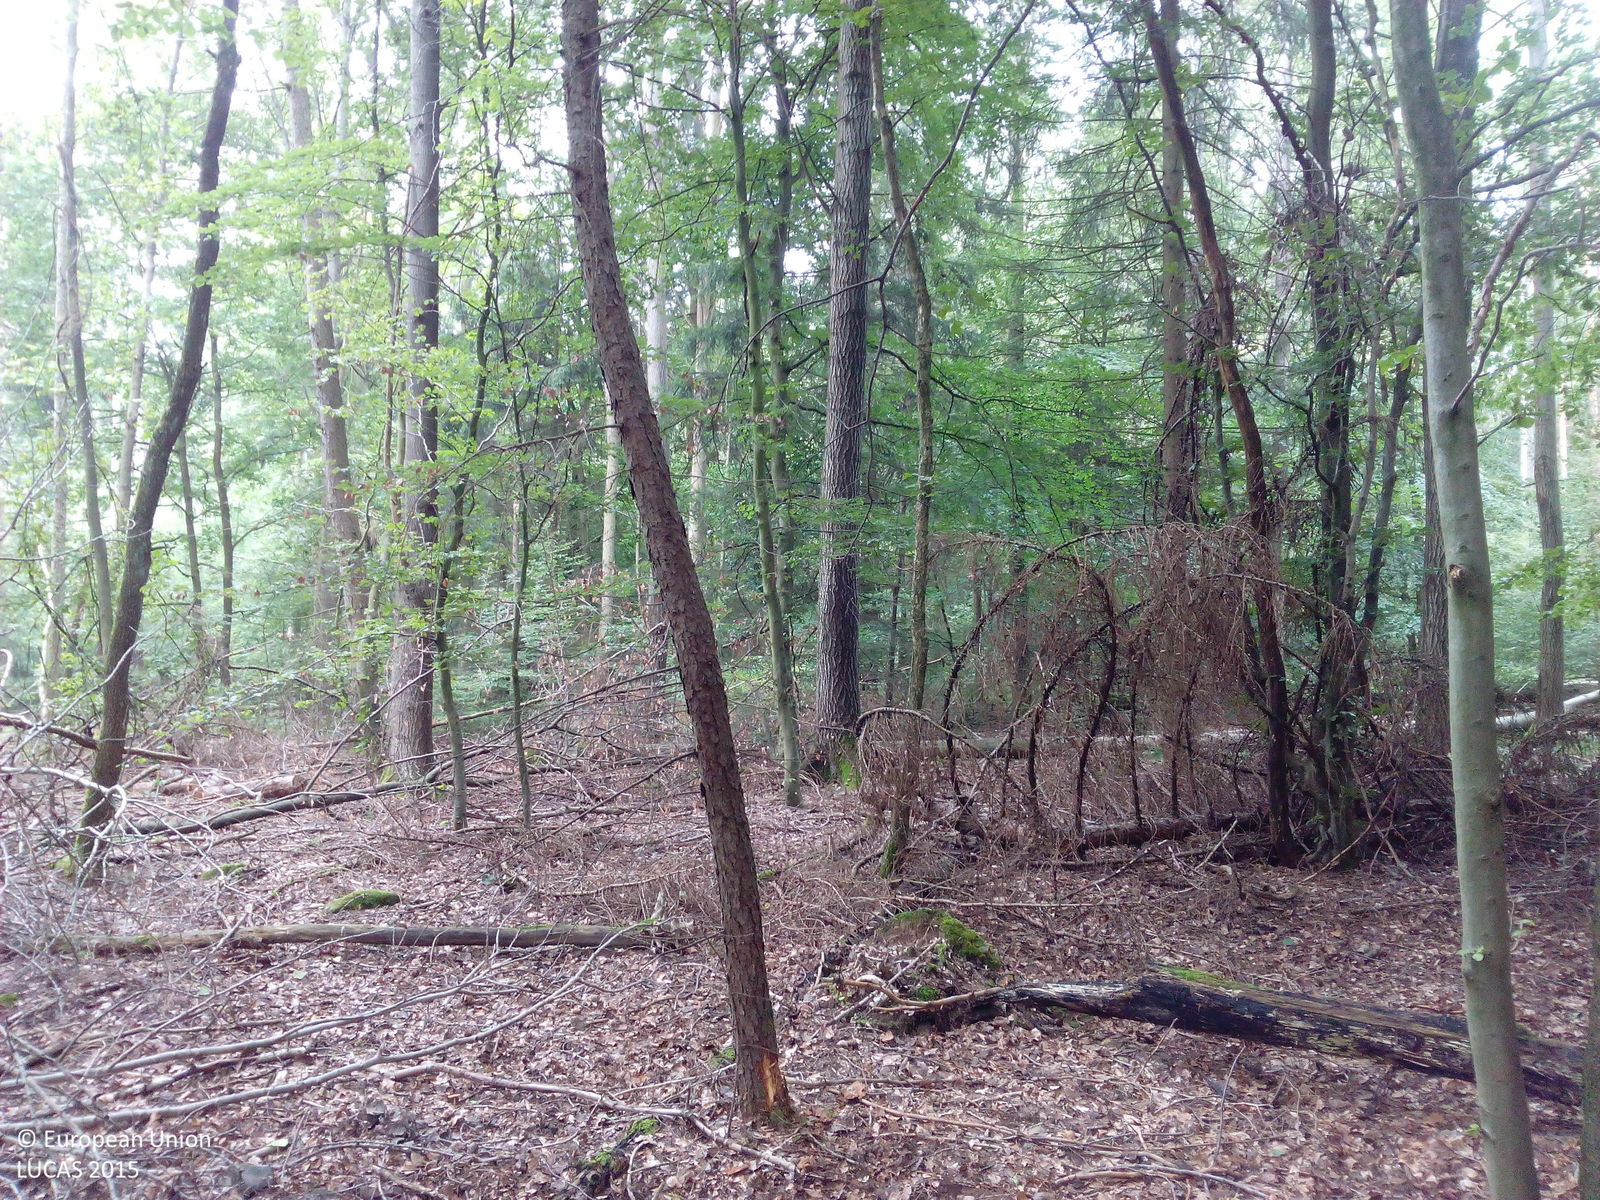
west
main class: Woodland
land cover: Spruce dominated mixed woodland
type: hemiboreal forest and nemoral coniferous forest and mixed broadleaved-coniferous forest
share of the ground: > 75 %
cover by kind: coniferous forest trees 60 %, broadleaved forest trees 40 %
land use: Forestry
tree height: > 5 m
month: September
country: DE
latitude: 51.3887
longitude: 9.8420
